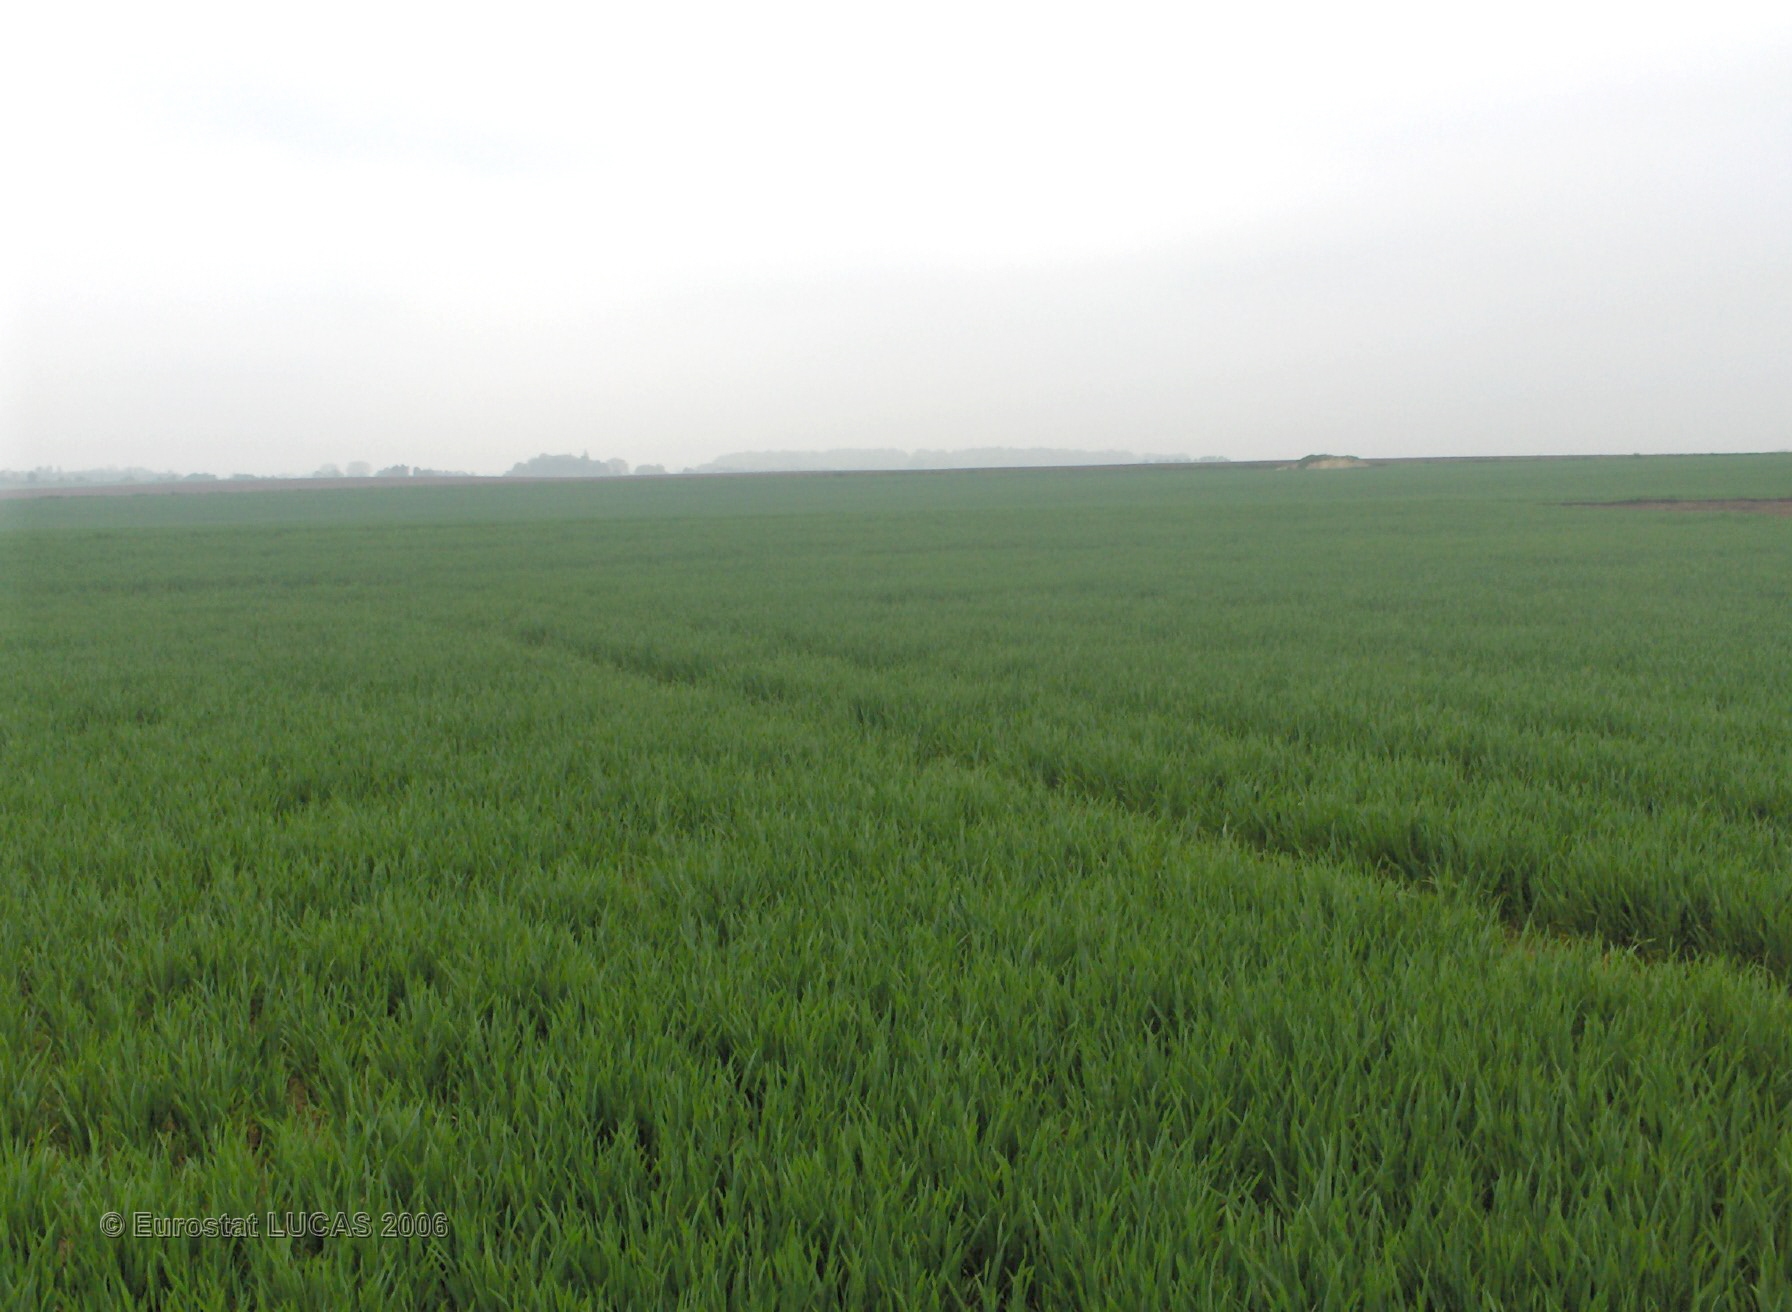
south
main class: Cropland
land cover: Common wheat
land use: Agriculture (excluding fallow land and kitchen gardens)
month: May
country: BE
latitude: 50.5385
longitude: 4.5071
